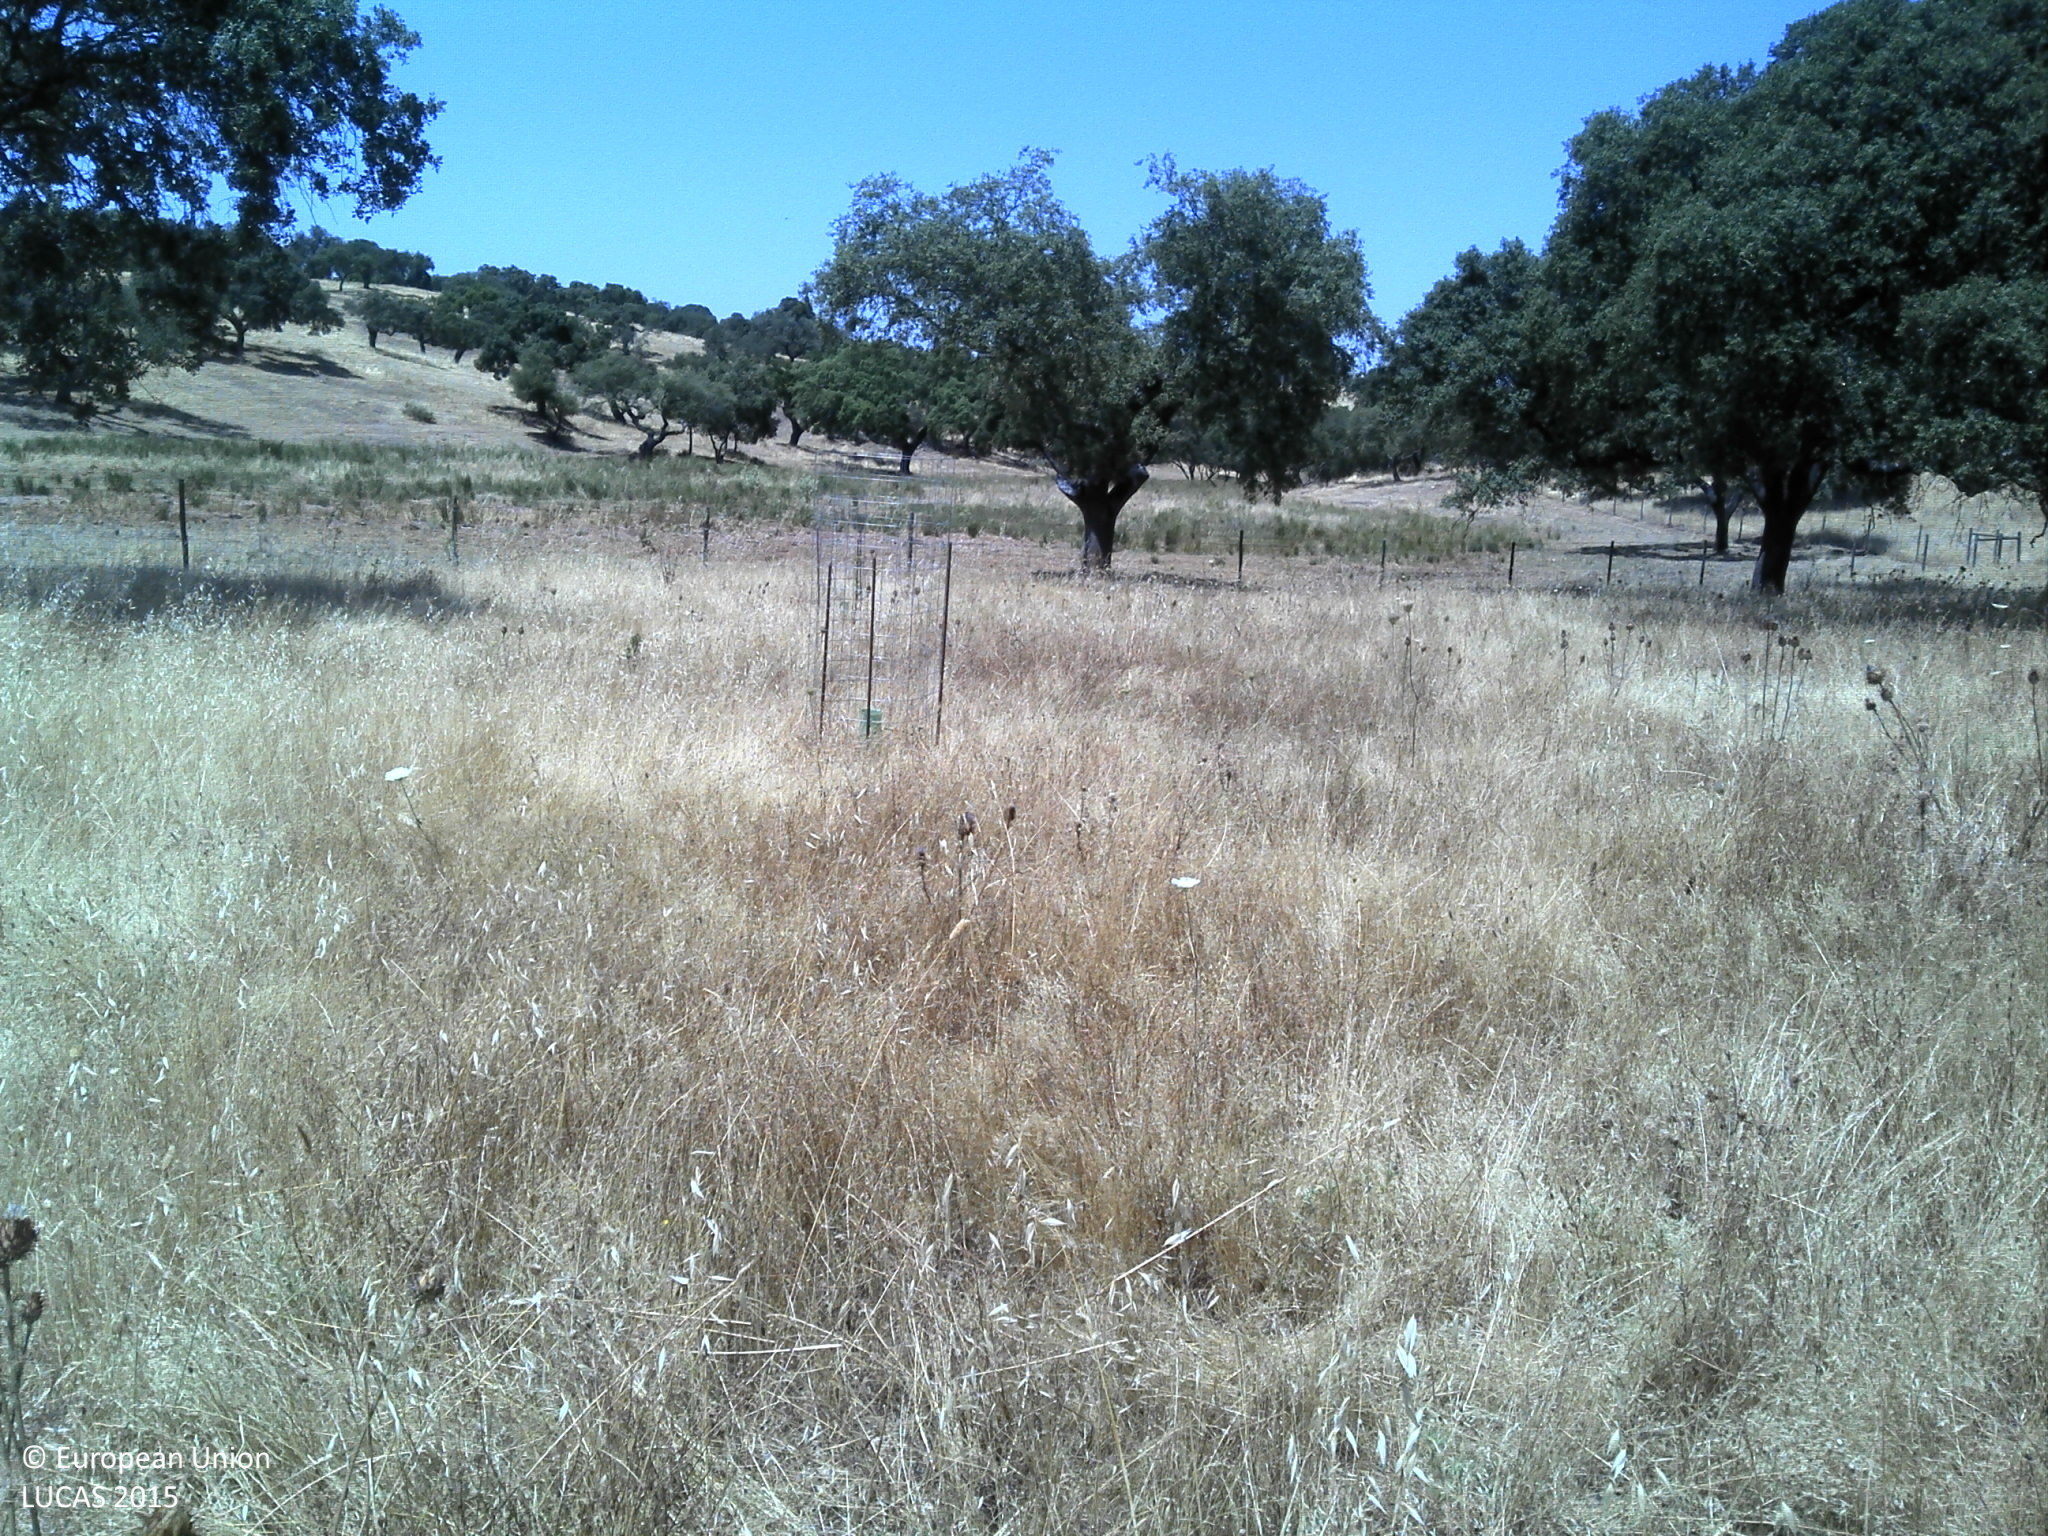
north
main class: Woodland
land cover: Broadleaved woodland
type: broadleaved evergreen forest
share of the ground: 25 - 50 %
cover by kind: herbaceous plants 70 %, broadleaved forest trees 30 %
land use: Forestry
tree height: > 5 m
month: June
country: PT
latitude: 37.9990
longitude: -7.2898
